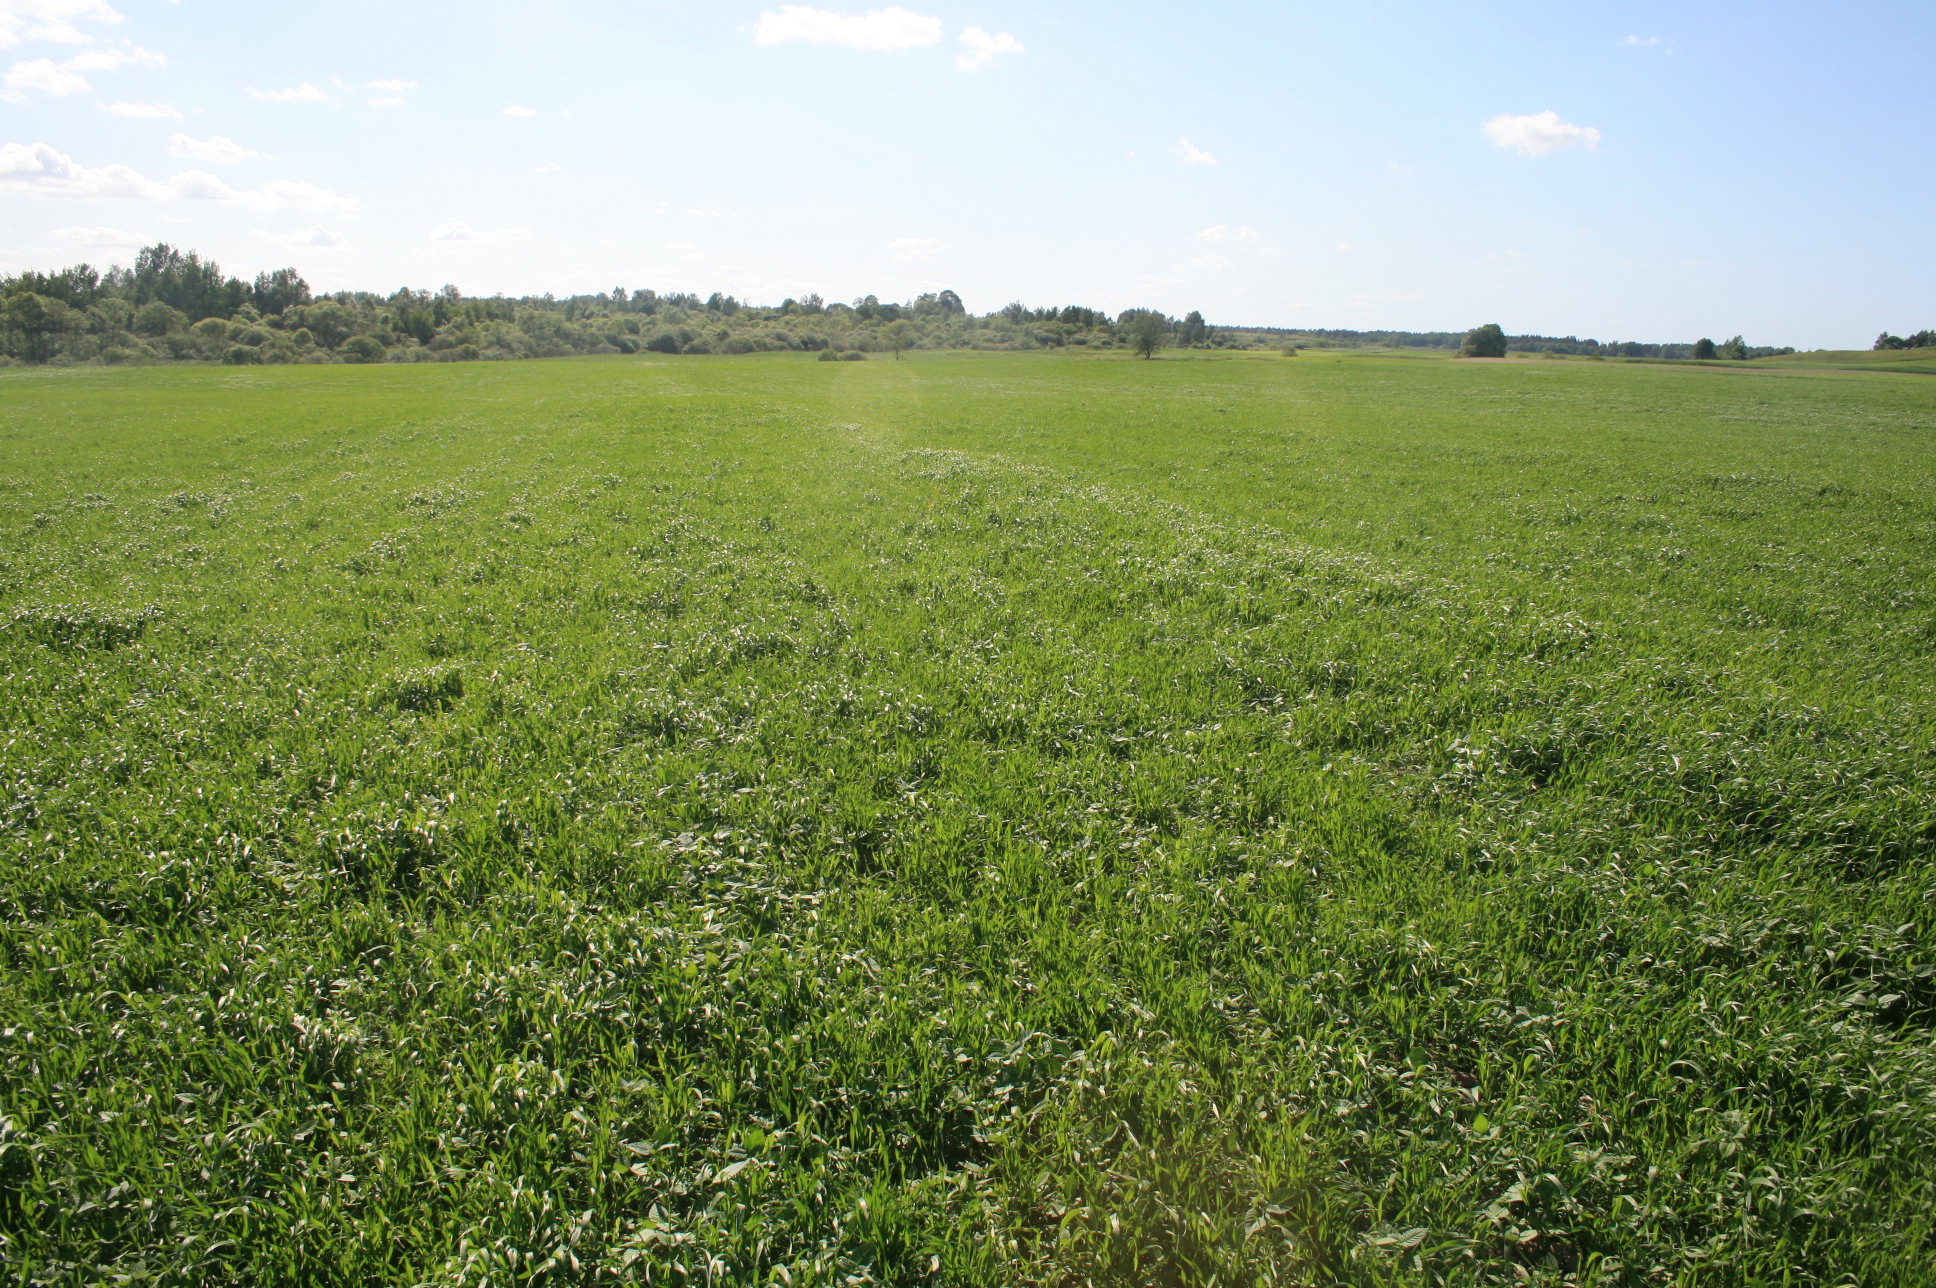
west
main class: Cropland
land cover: Common wheat
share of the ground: > 75 %
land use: Agriculture (excluding fallow land and kitchen gardens)
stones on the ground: < 10 %
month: June
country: LT
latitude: 56.0242
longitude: 22.3632
